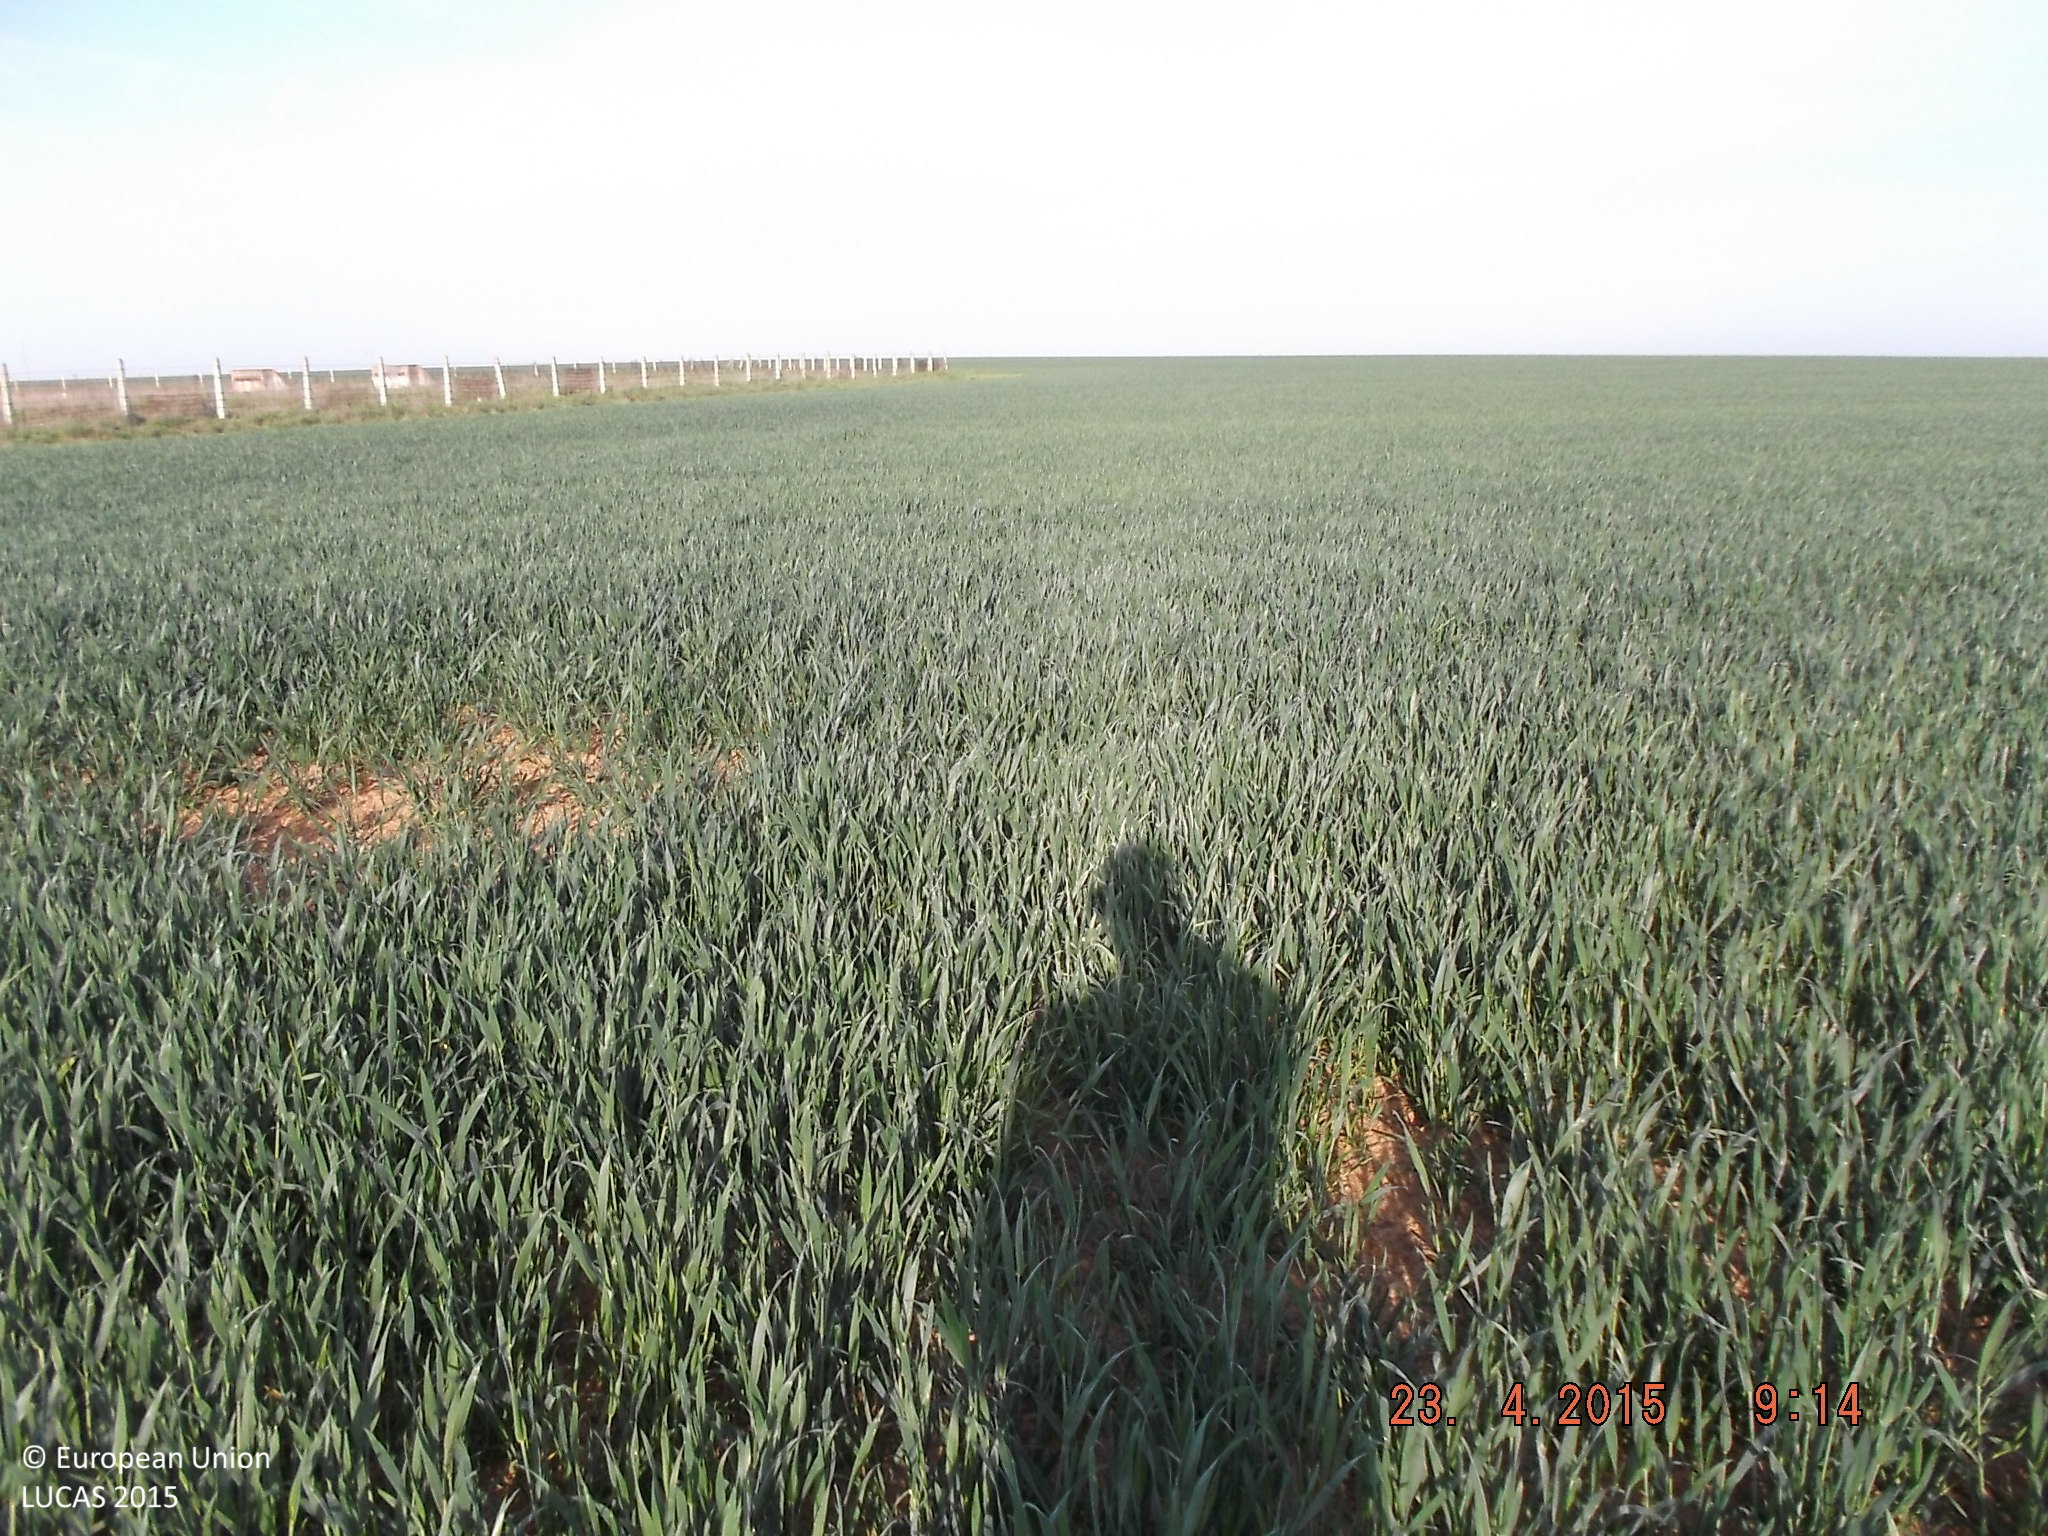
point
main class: Cropland
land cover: Common wheat
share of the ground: > 75 %
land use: Agriculture (excluding fallow land and kitchen gardens)
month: April
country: ES
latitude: 40.9135
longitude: -5.8838
